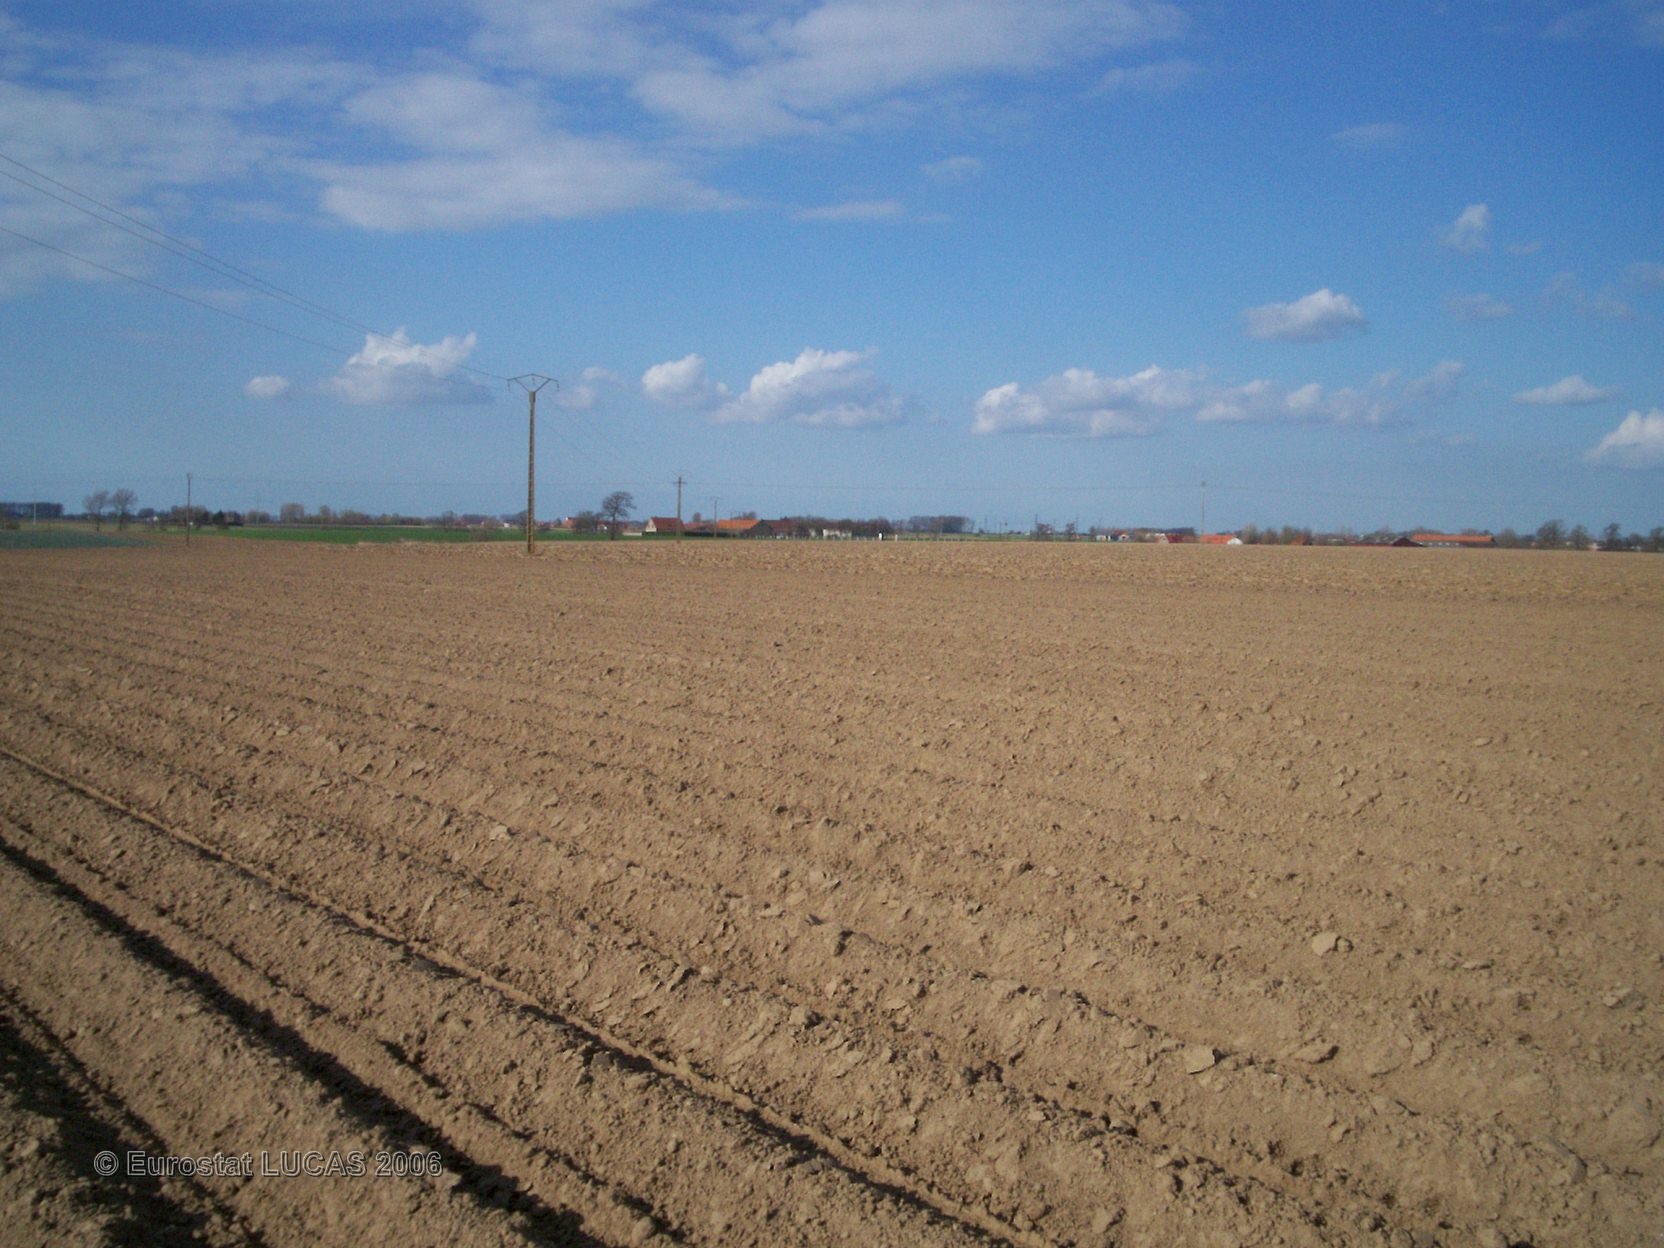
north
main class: Cropland
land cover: Potatoes
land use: Agriculture (excluding fallow land and kitchen gardens)
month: May
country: FR
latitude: 50.8920
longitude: 2.4664
